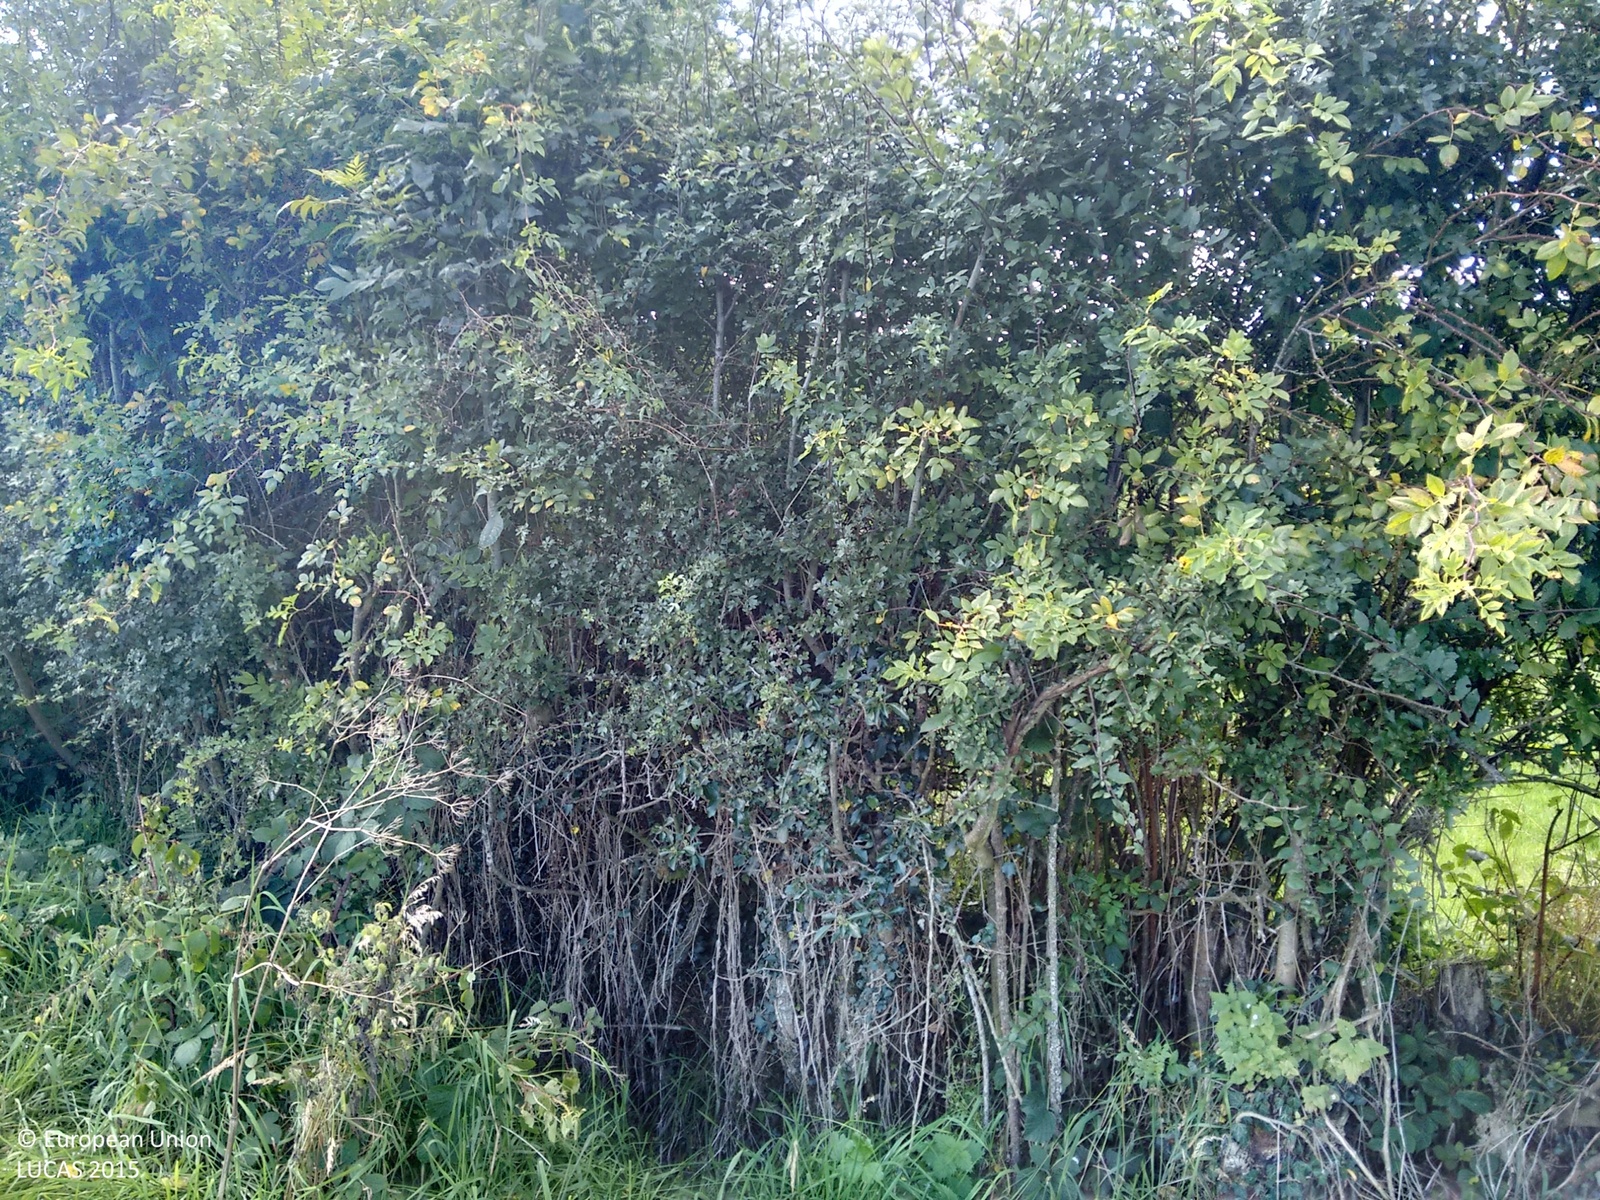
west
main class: Grassland
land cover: Grassland without tree/shrub cover
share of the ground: > 75 %
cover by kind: herbaceous plants 100 %
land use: Agriculture (excluding fallow land and kitchen gardens)
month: September
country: IE
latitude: 54.2119
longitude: -6.8652
